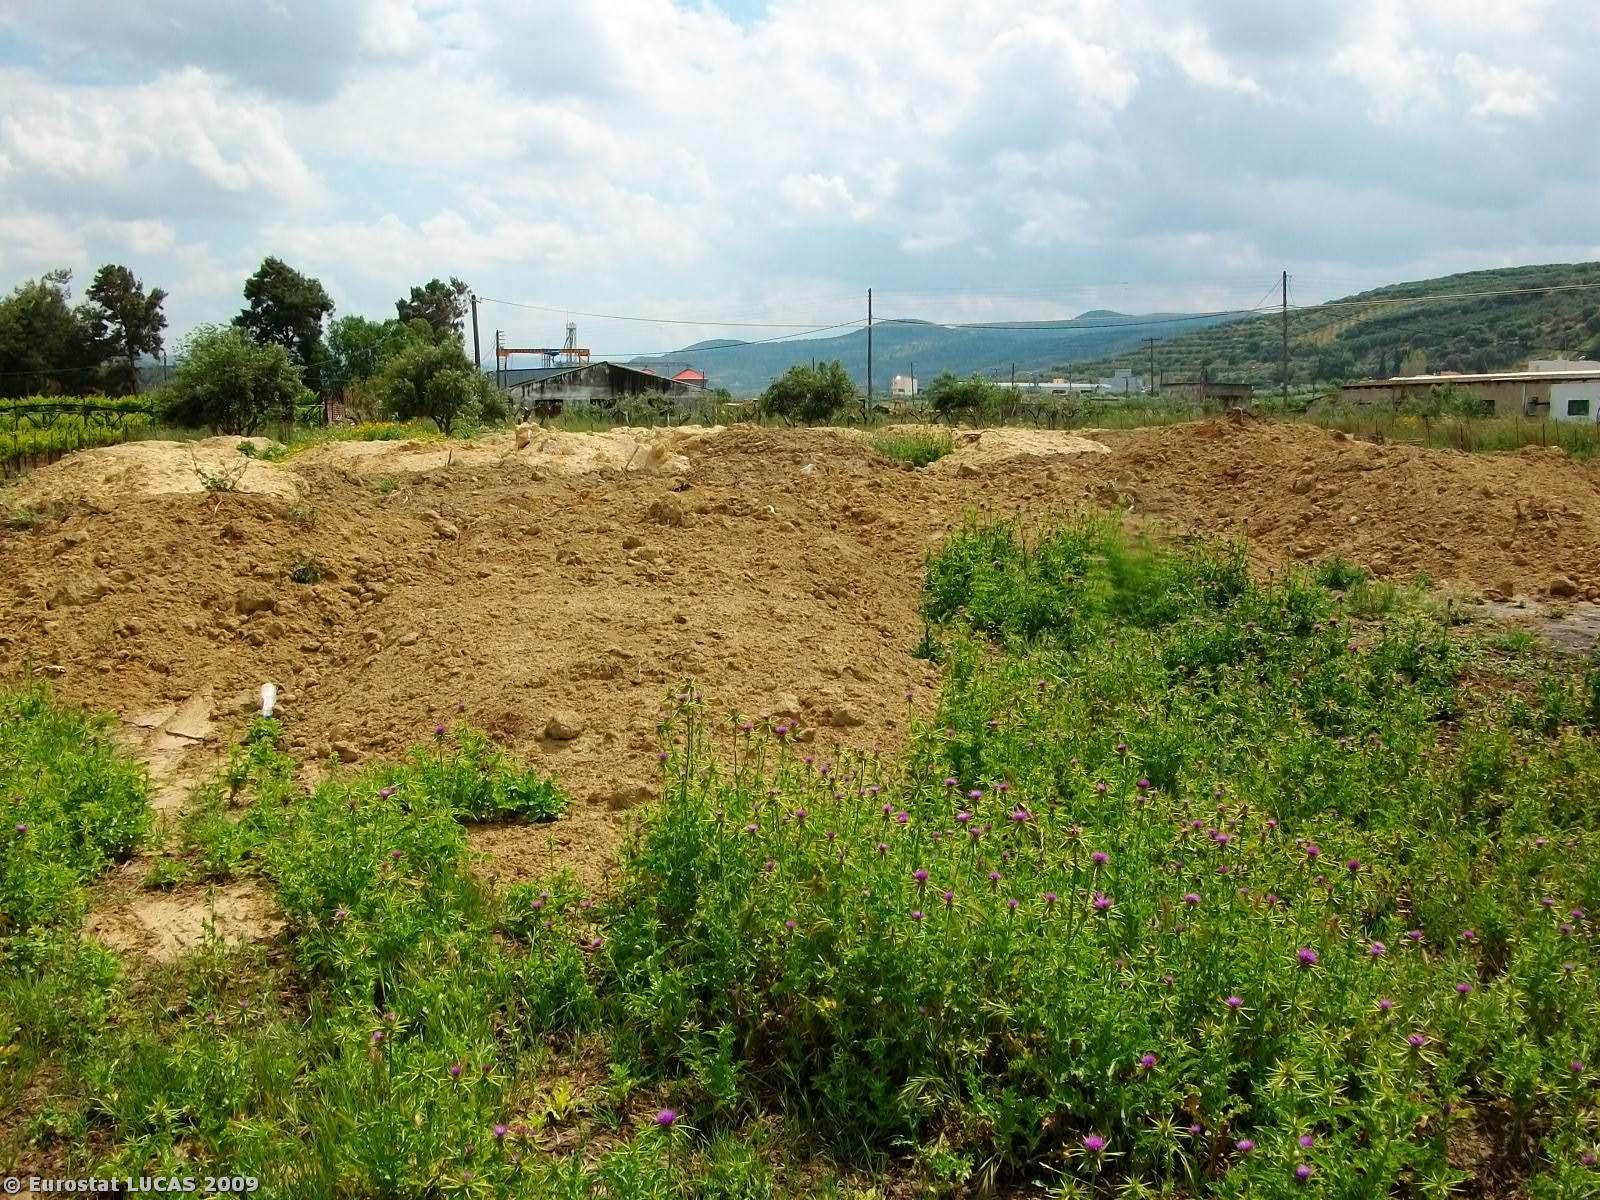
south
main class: Grassland
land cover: Spontaneously vegetated surfaces
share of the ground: 50 - 75 %
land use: Unused
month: May
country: GR
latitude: 35.2797
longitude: 25.1091
